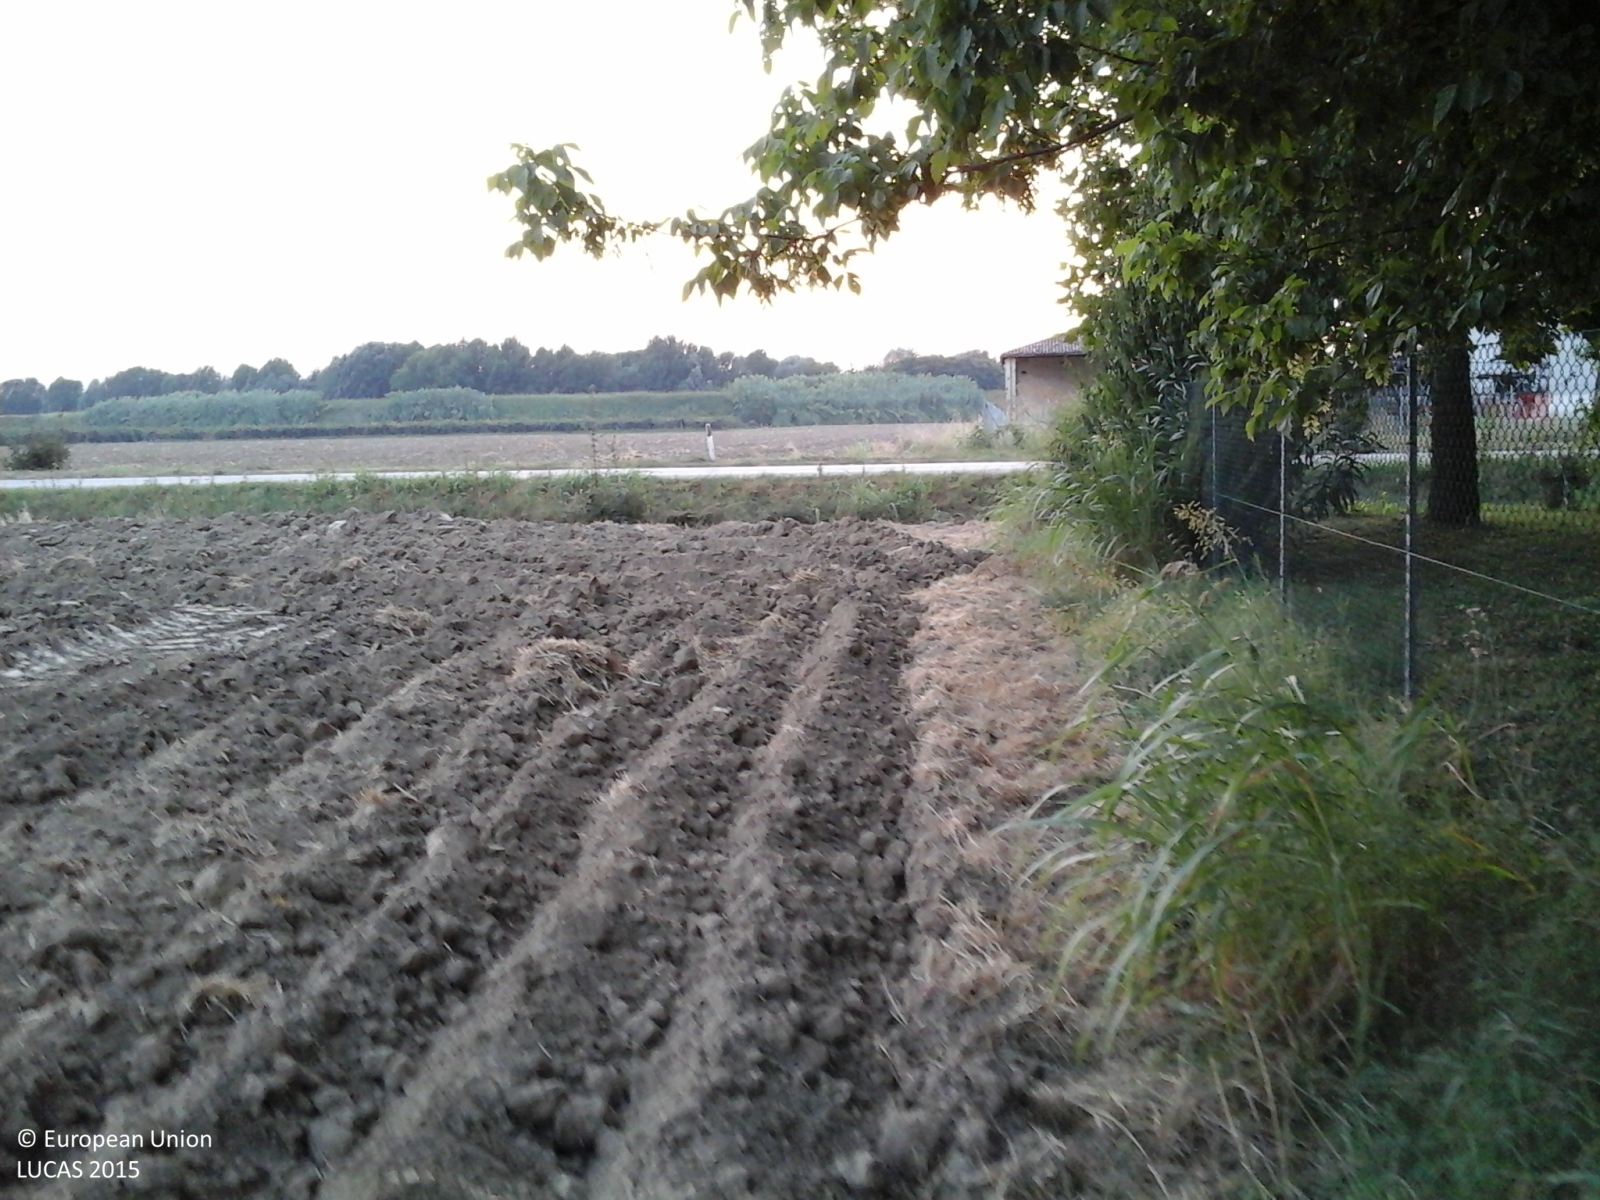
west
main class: Woodland
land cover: Broadleaved woodland
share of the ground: > 75 %
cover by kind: broadleaved forest trees 100 %
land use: Residential
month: July
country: IT
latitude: 44.3338
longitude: 11.8645
